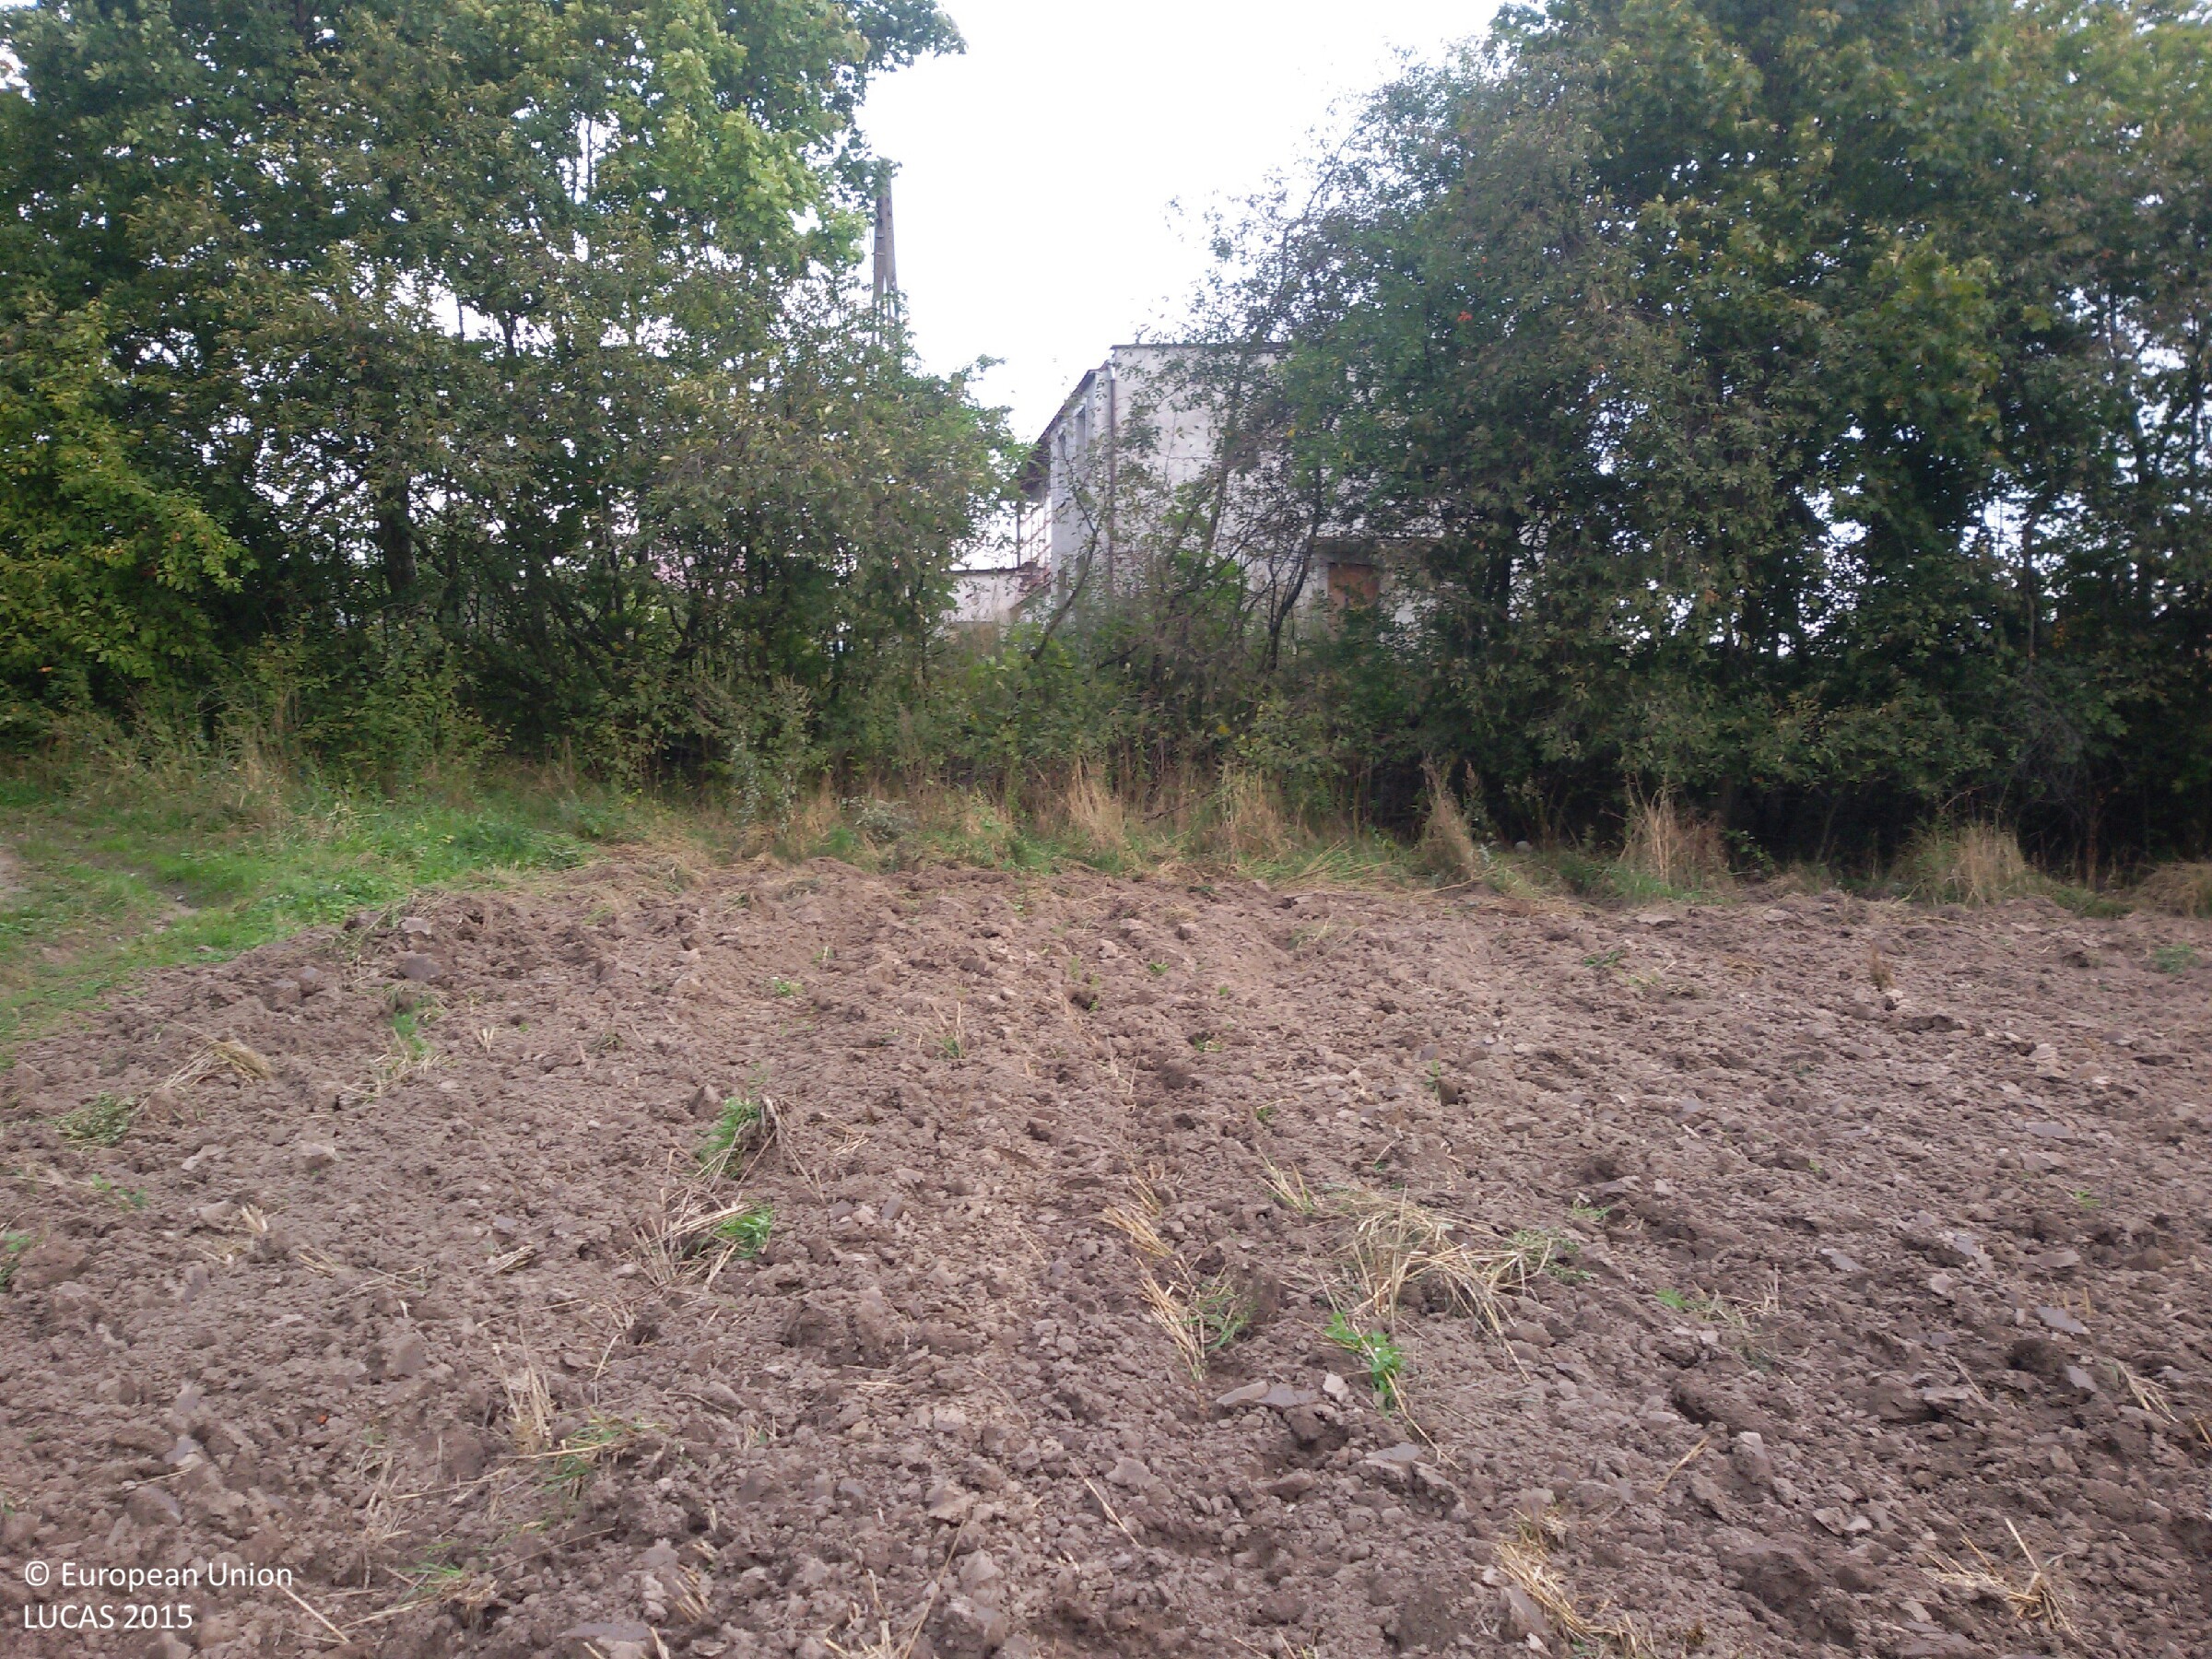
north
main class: Cropland
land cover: Triticale
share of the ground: 10 - 25 %
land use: Agriculture (excluding fallow land and kitchen gardens)
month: September
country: PL
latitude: 54.2128
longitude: 19.3938
